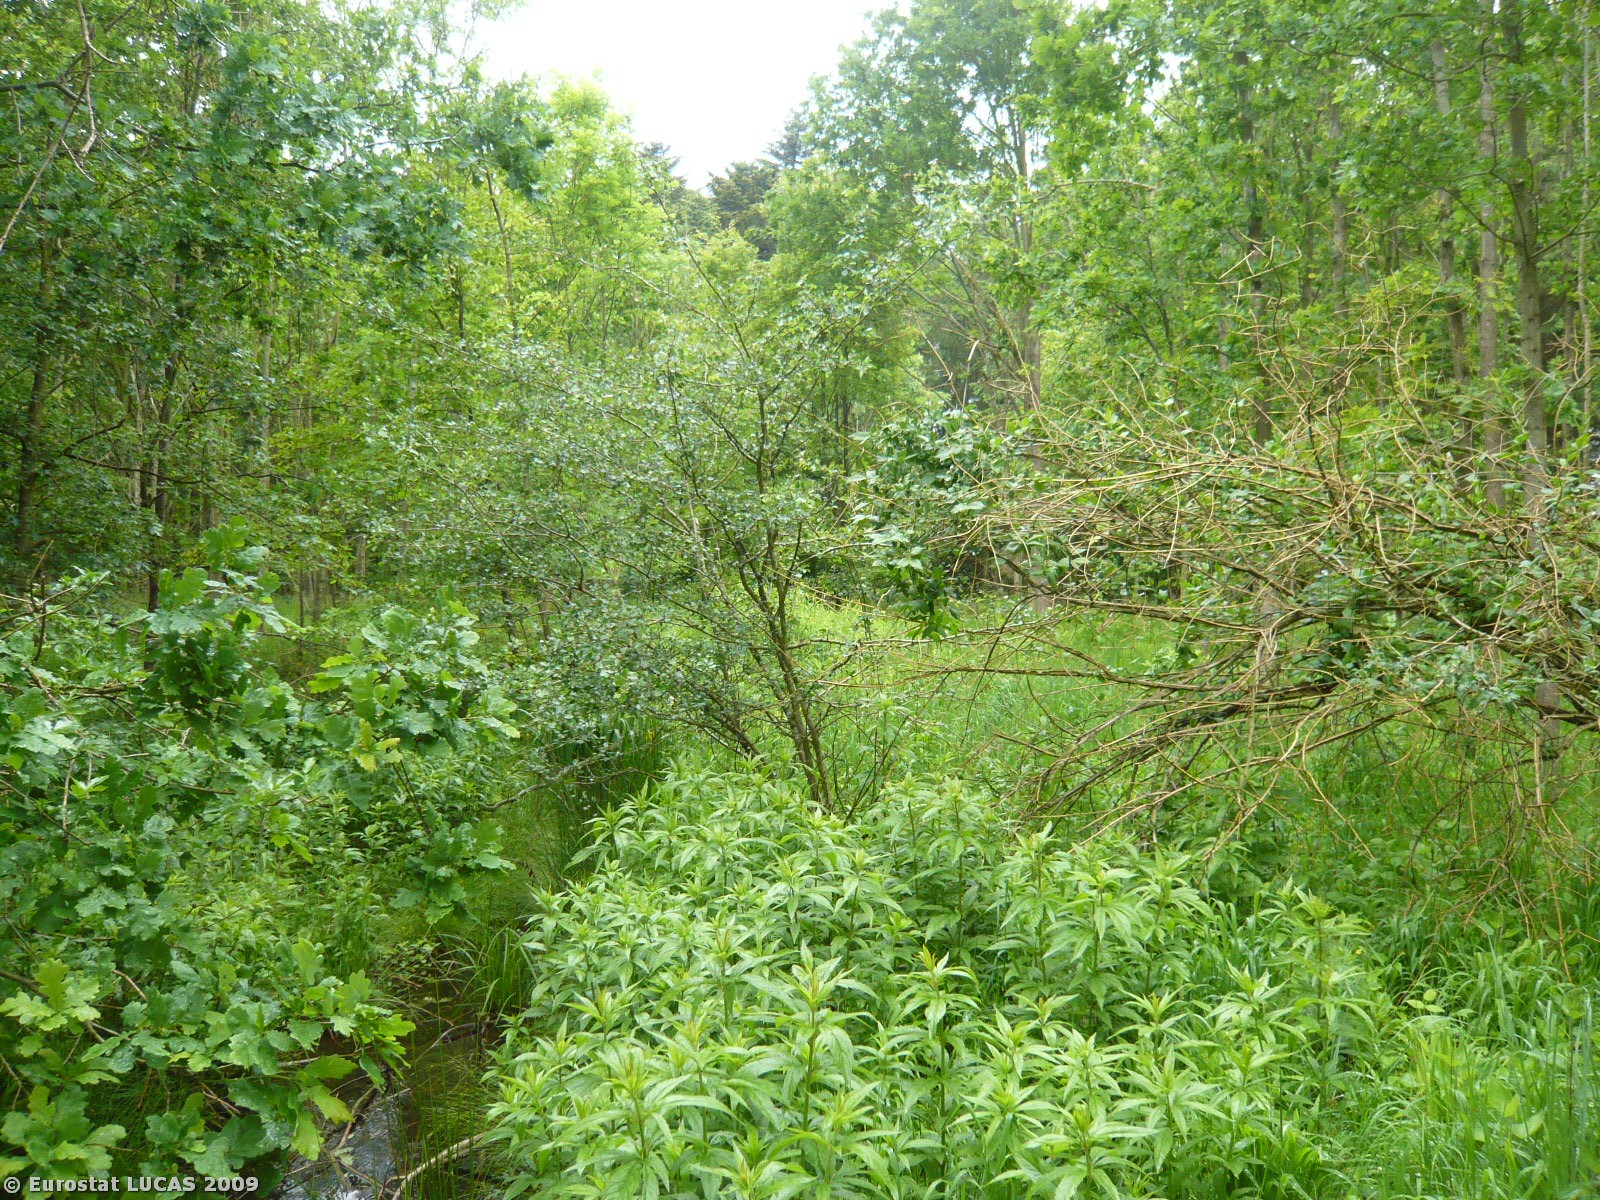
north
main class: Woodland
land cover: Broadleaved woodland
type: plantations and self-sown exotic forest
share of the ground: > 75 %
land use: Forestry
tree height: > 5 m
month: June
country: DK
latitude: 54.7532
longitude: 11.9100
